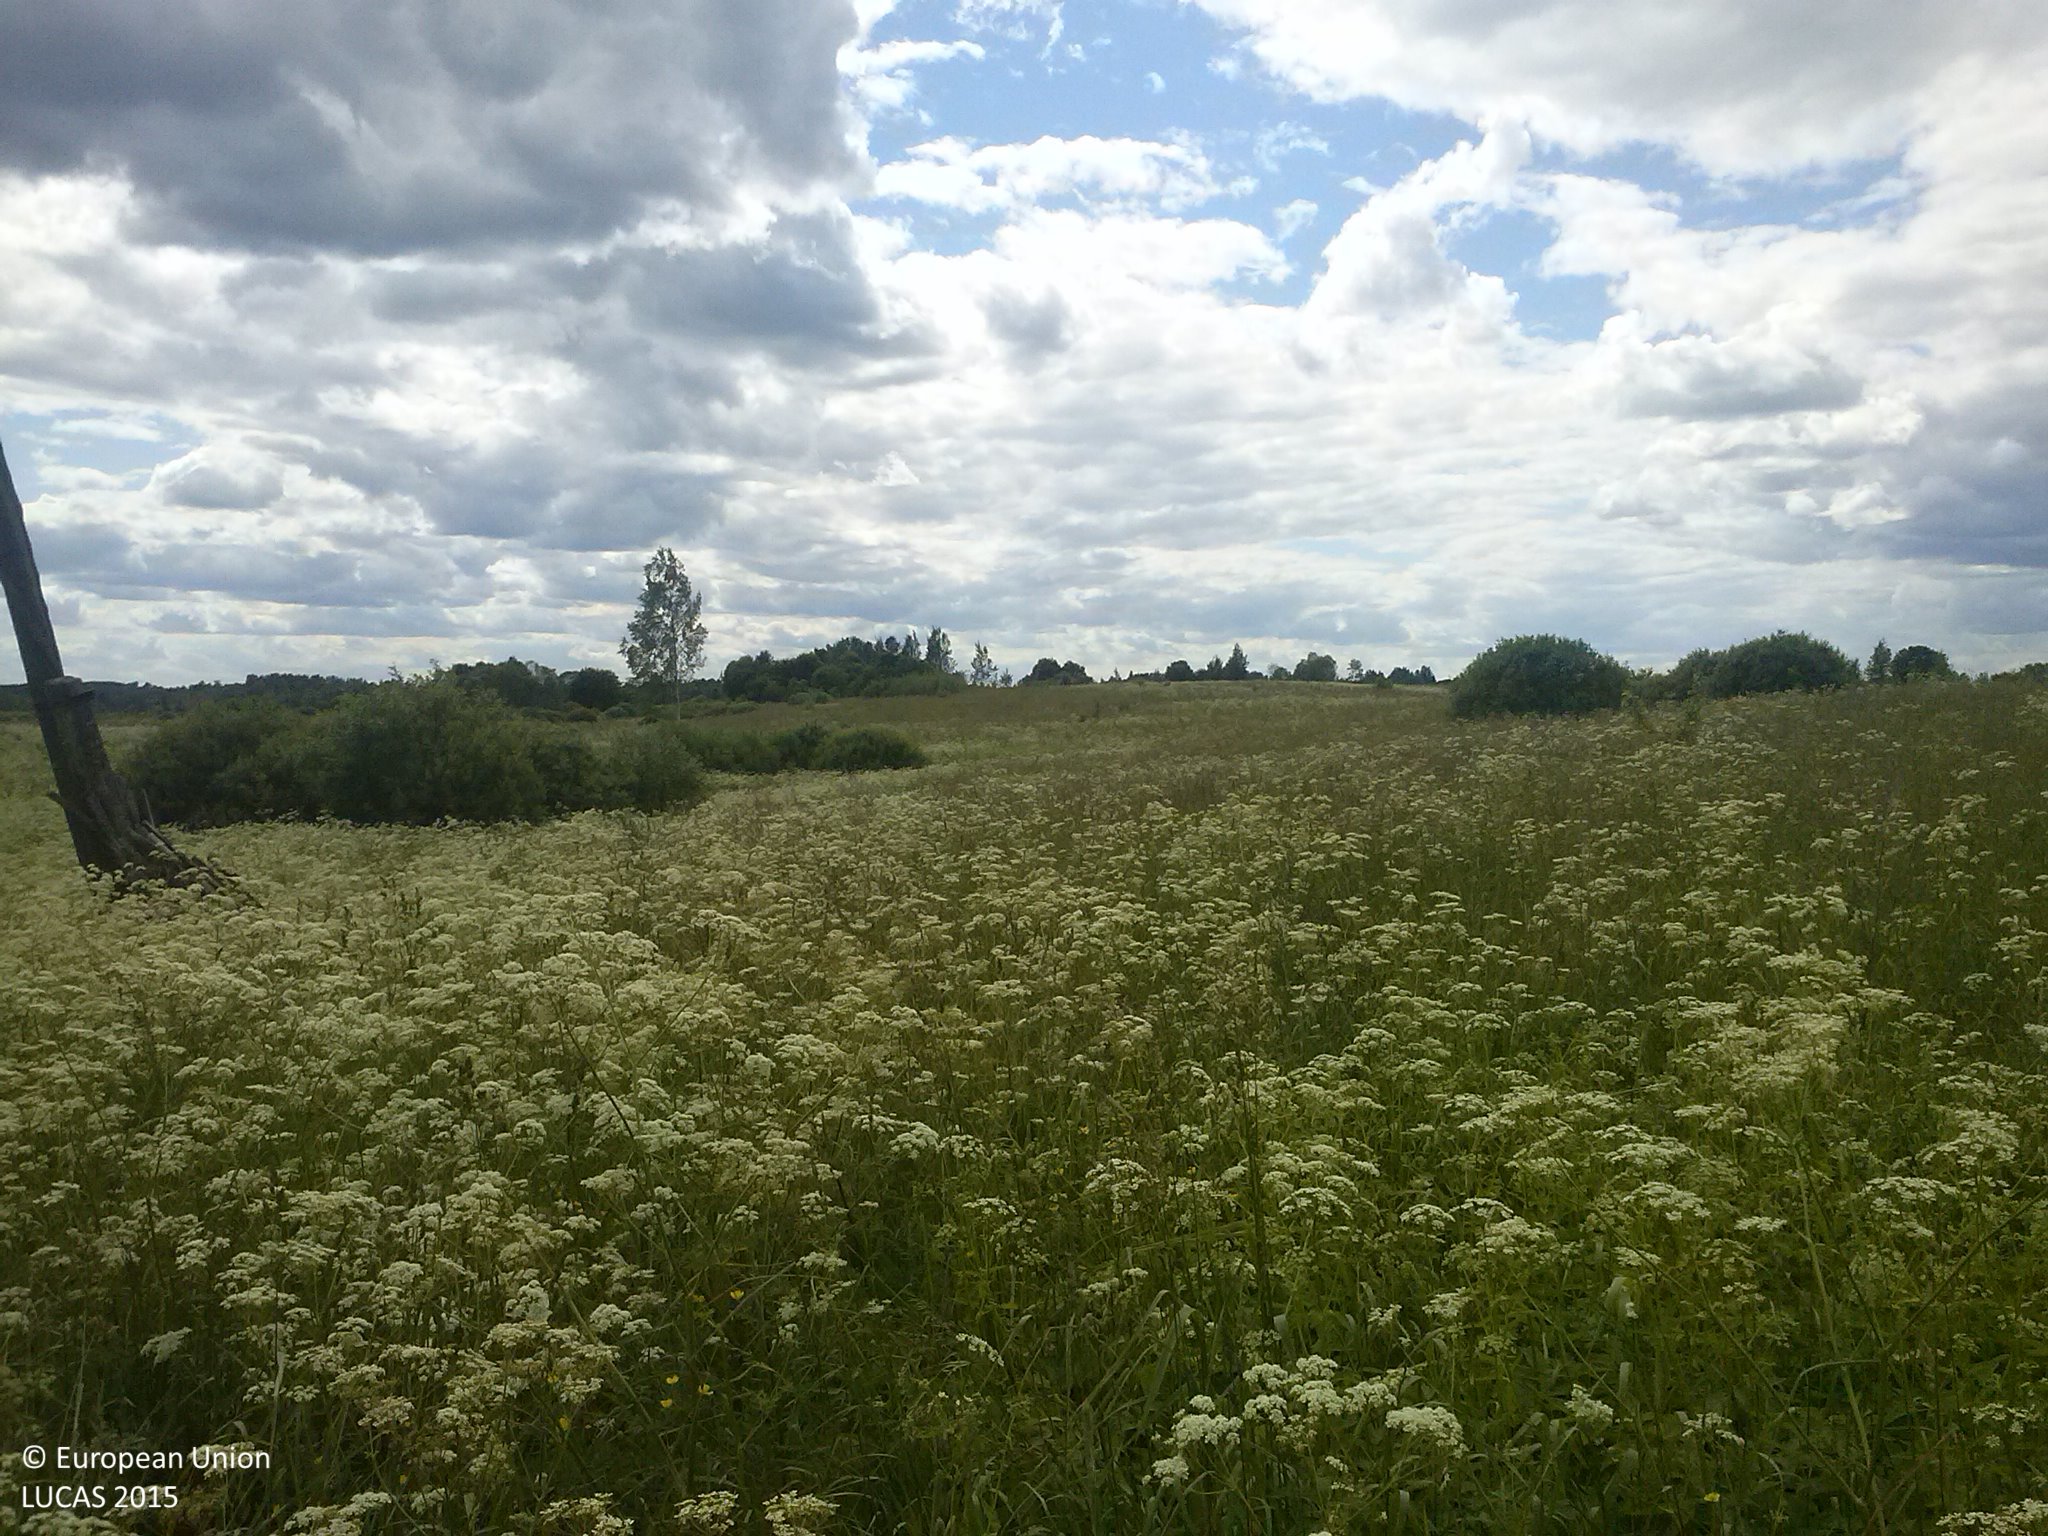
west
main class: Grassland
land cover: Spontaneously vegetated surfaces
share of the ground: > 75 %
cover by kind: herbaceous plants 100 %
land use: Semi-natural and natural areas not in use
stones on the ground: < 10 %
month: June
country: LV
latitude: 56.4224
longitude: 27.6786
